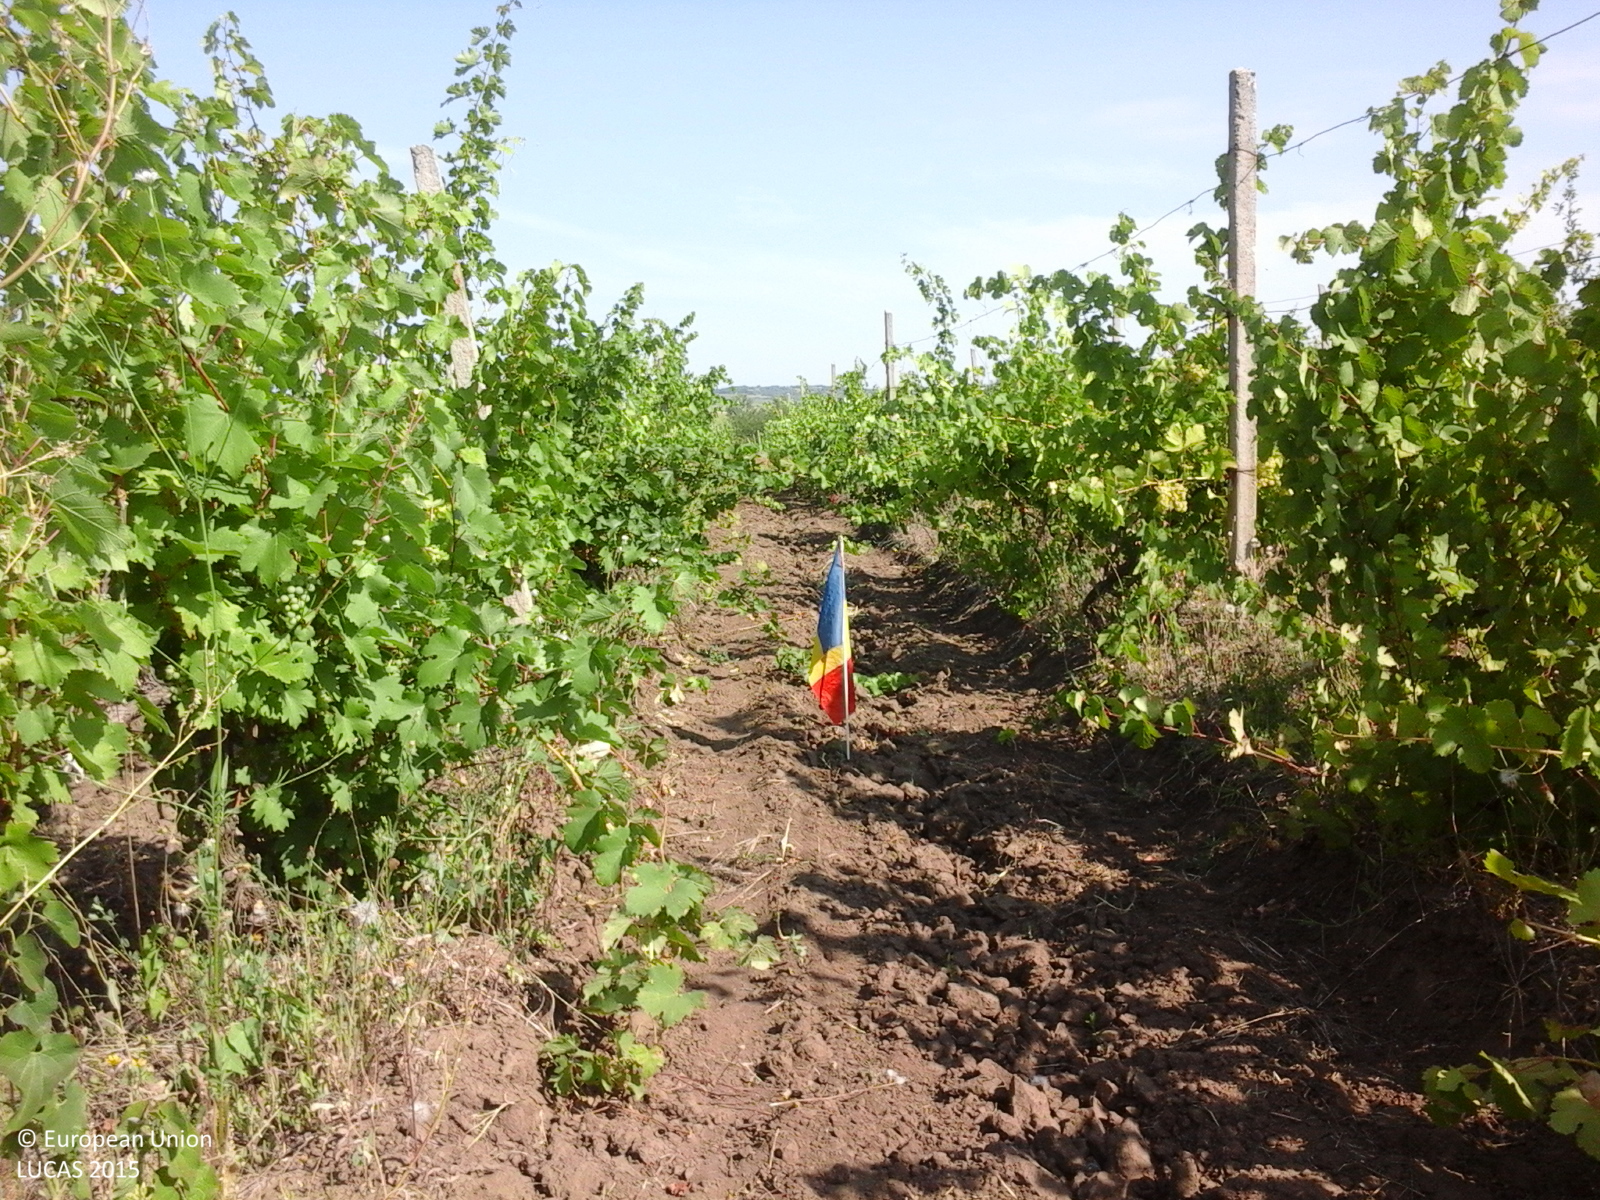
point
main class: Cropland
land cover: Vineyards
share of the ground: 50 - 75 %
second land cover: Other bare soil
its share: > 75 %
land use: Agriculture (excluding fallow land and kitchen gardens)
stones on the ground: < 10 %
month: July
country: RO
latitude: 46.0963
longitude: 28.0124
